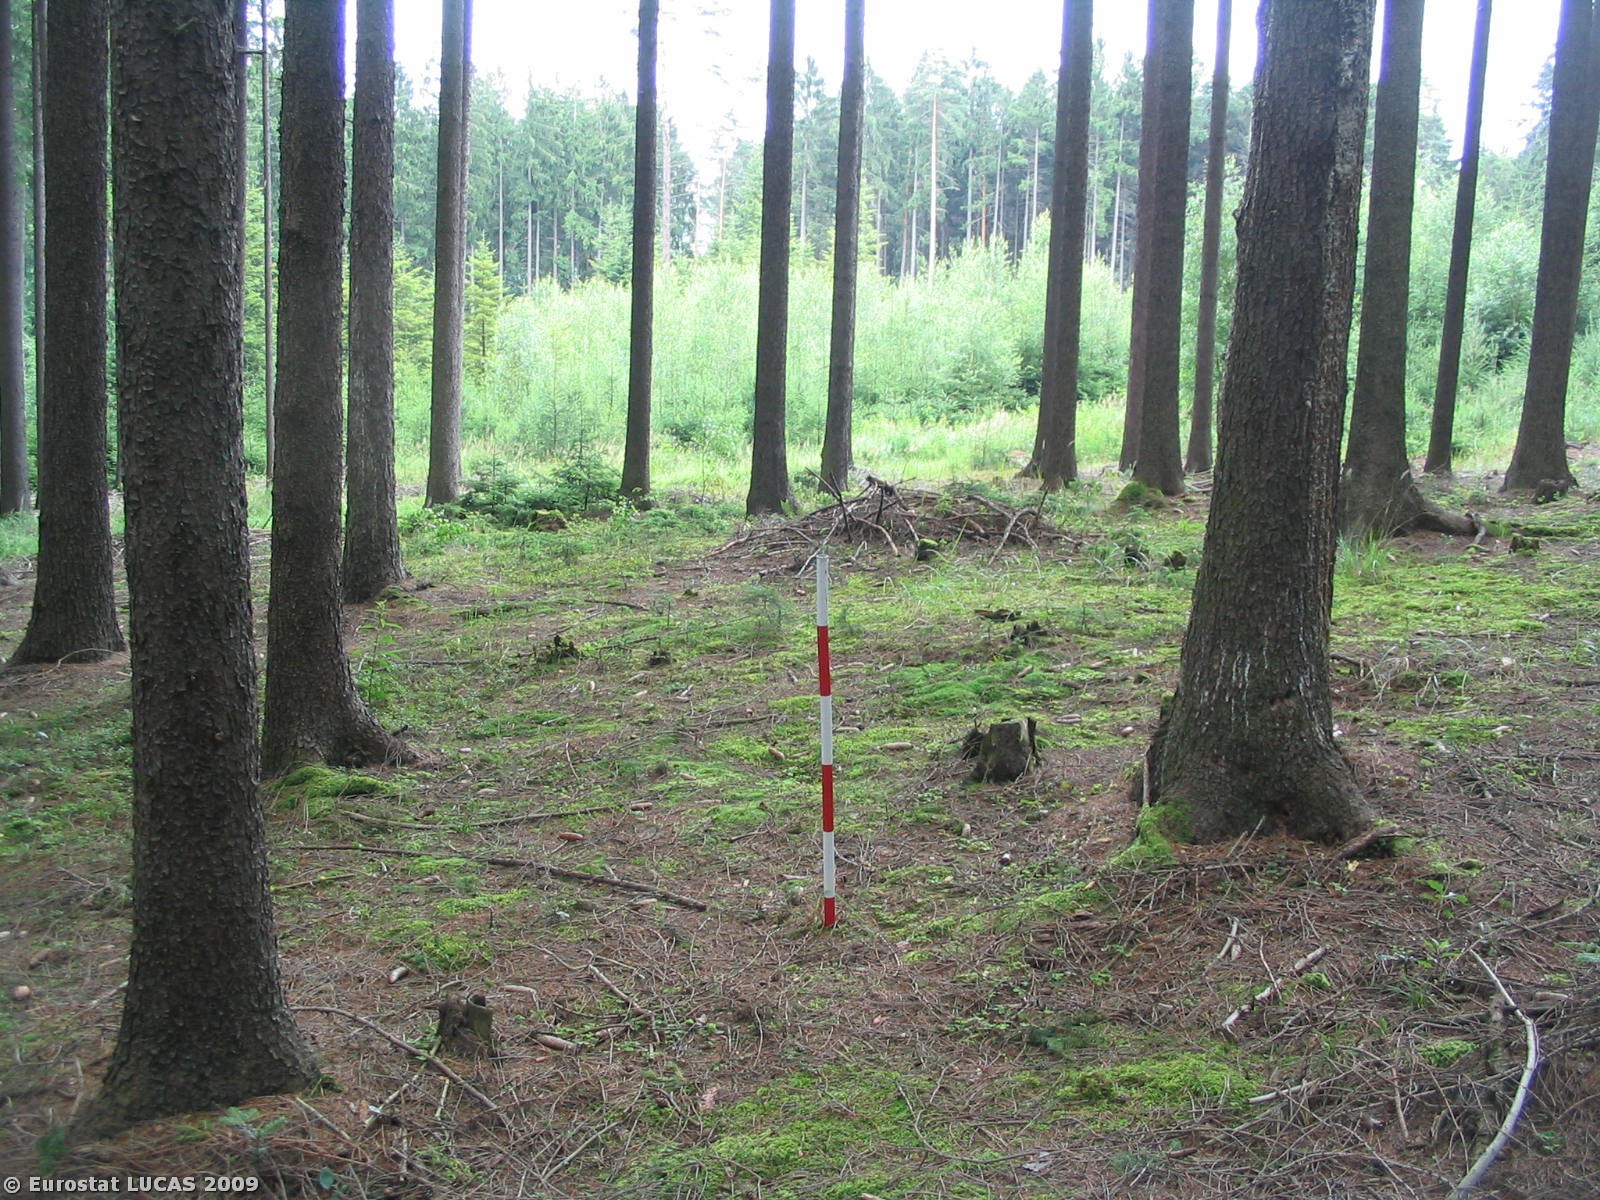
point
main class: Woodland
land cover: Coniferous woodland
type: hemiboreal forest and nemoral coniferous forest and mixed broadleaved-coniferous forest
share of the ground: > 75 %
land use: Forestry
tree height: > 5 m
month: July
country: CZ
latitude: 49.4051
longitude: 16.4704
